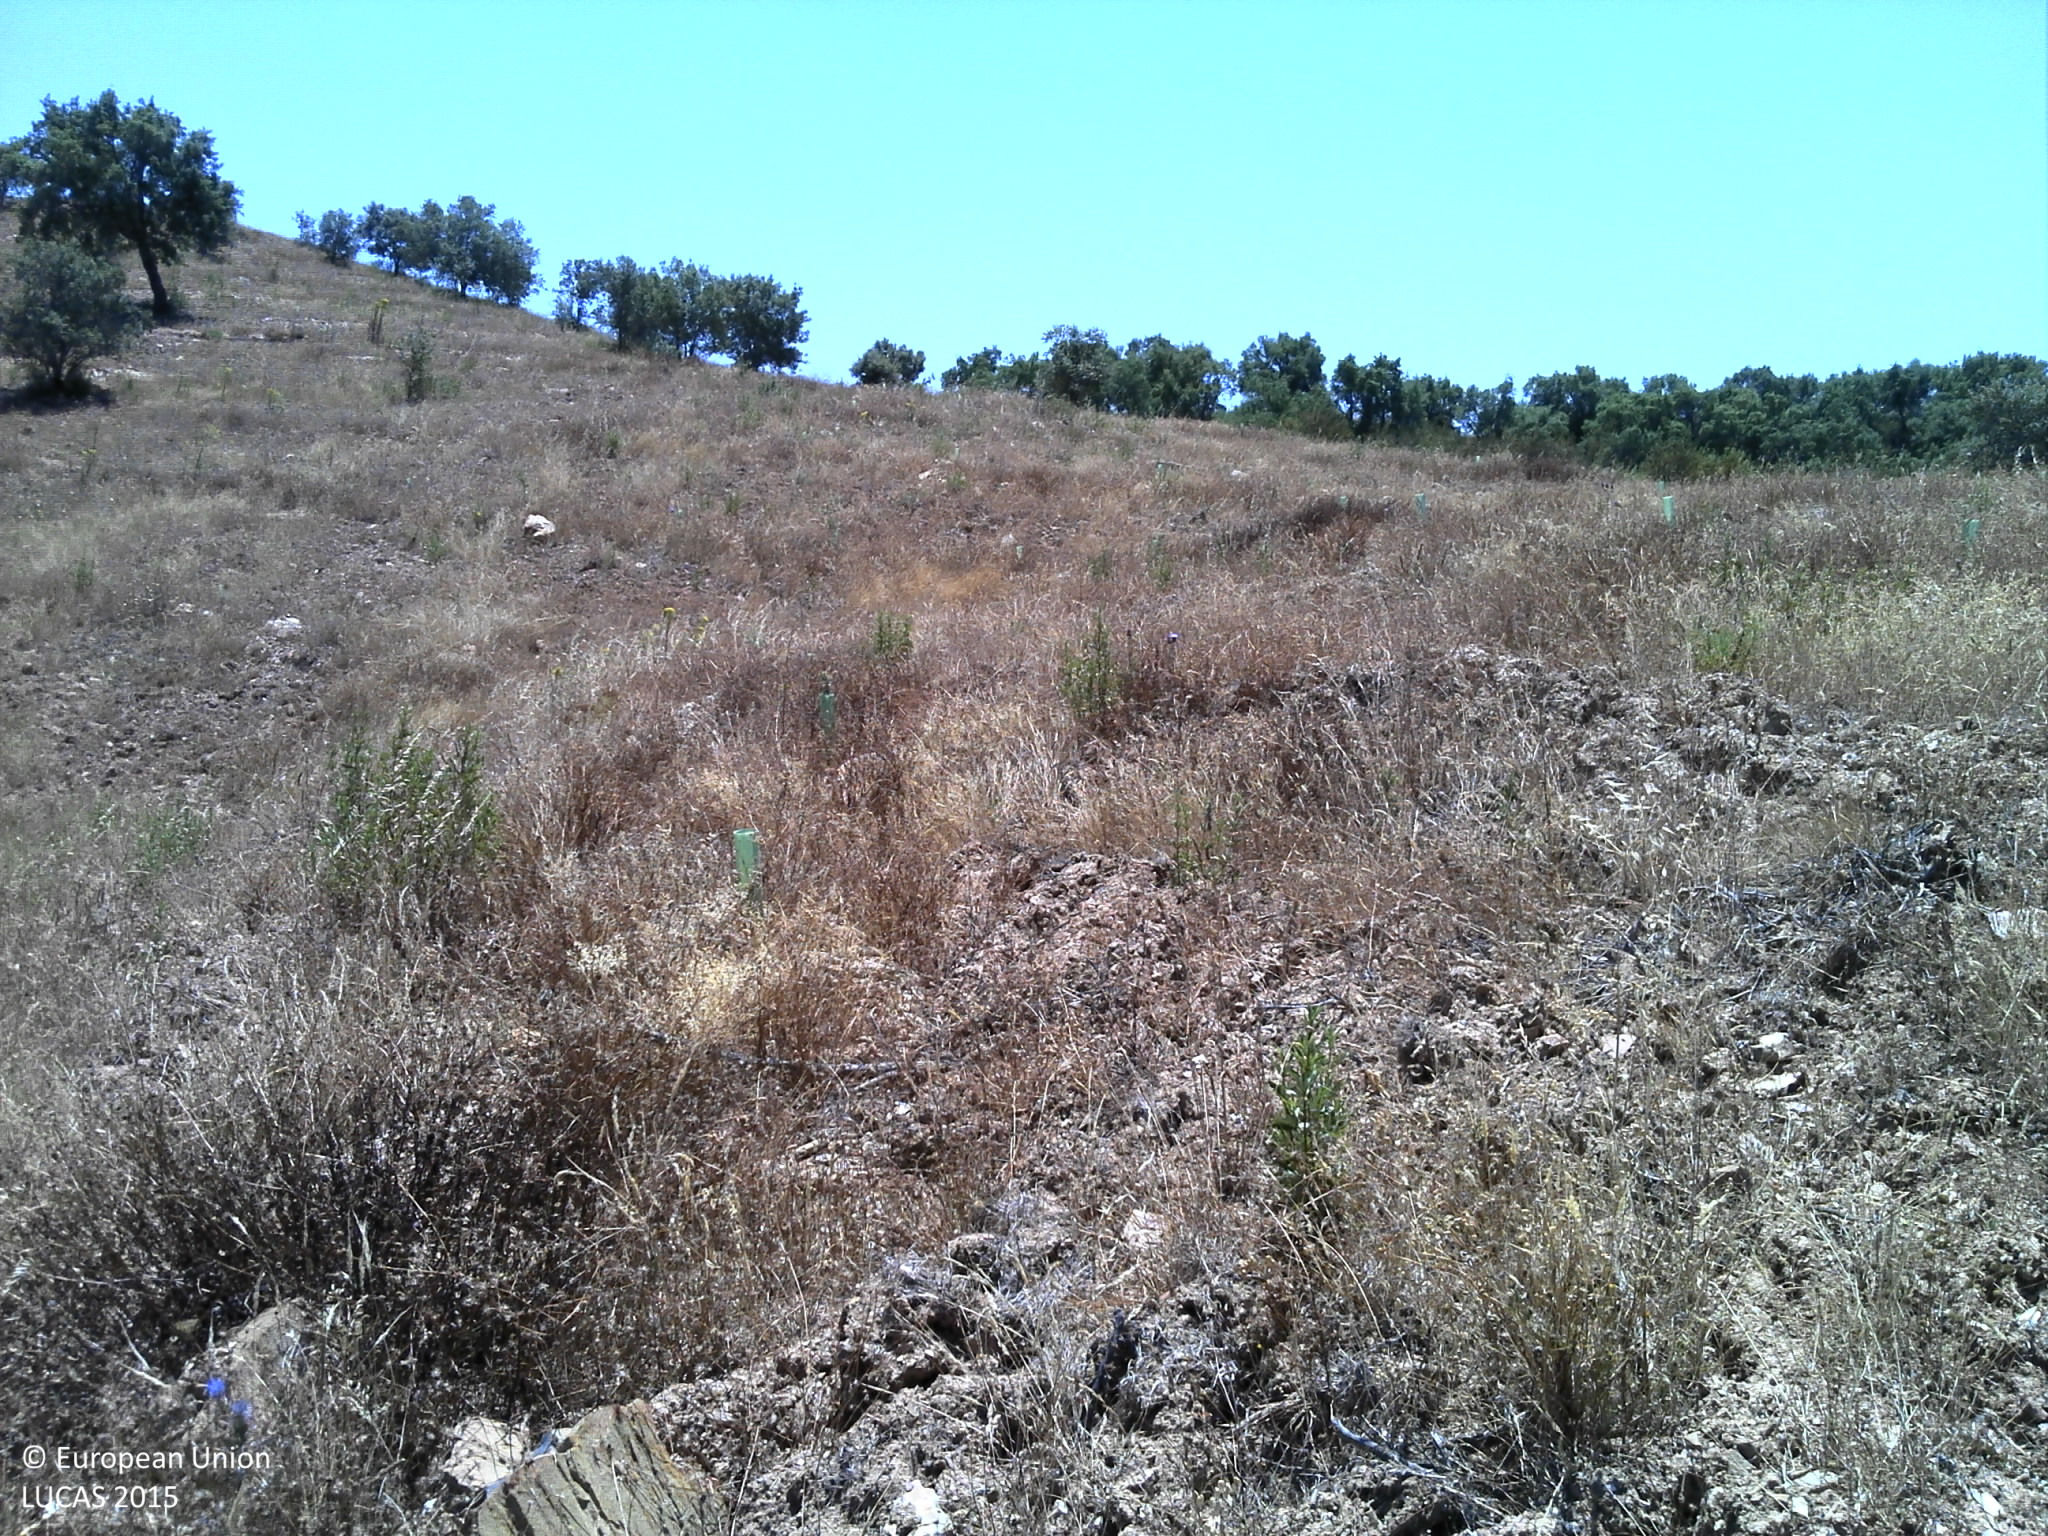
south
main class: Grassland
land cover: Grassland with sparse tree/shrub cover
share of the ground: 25 - 50 %
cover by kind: herbaceous plants 50 %, unconsolidated bare surface 45 %, broadleaved forest trees 5 %
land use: Forestry
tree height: < 5 m
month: June
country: PT
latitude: 37.7141
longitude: -8.4936
